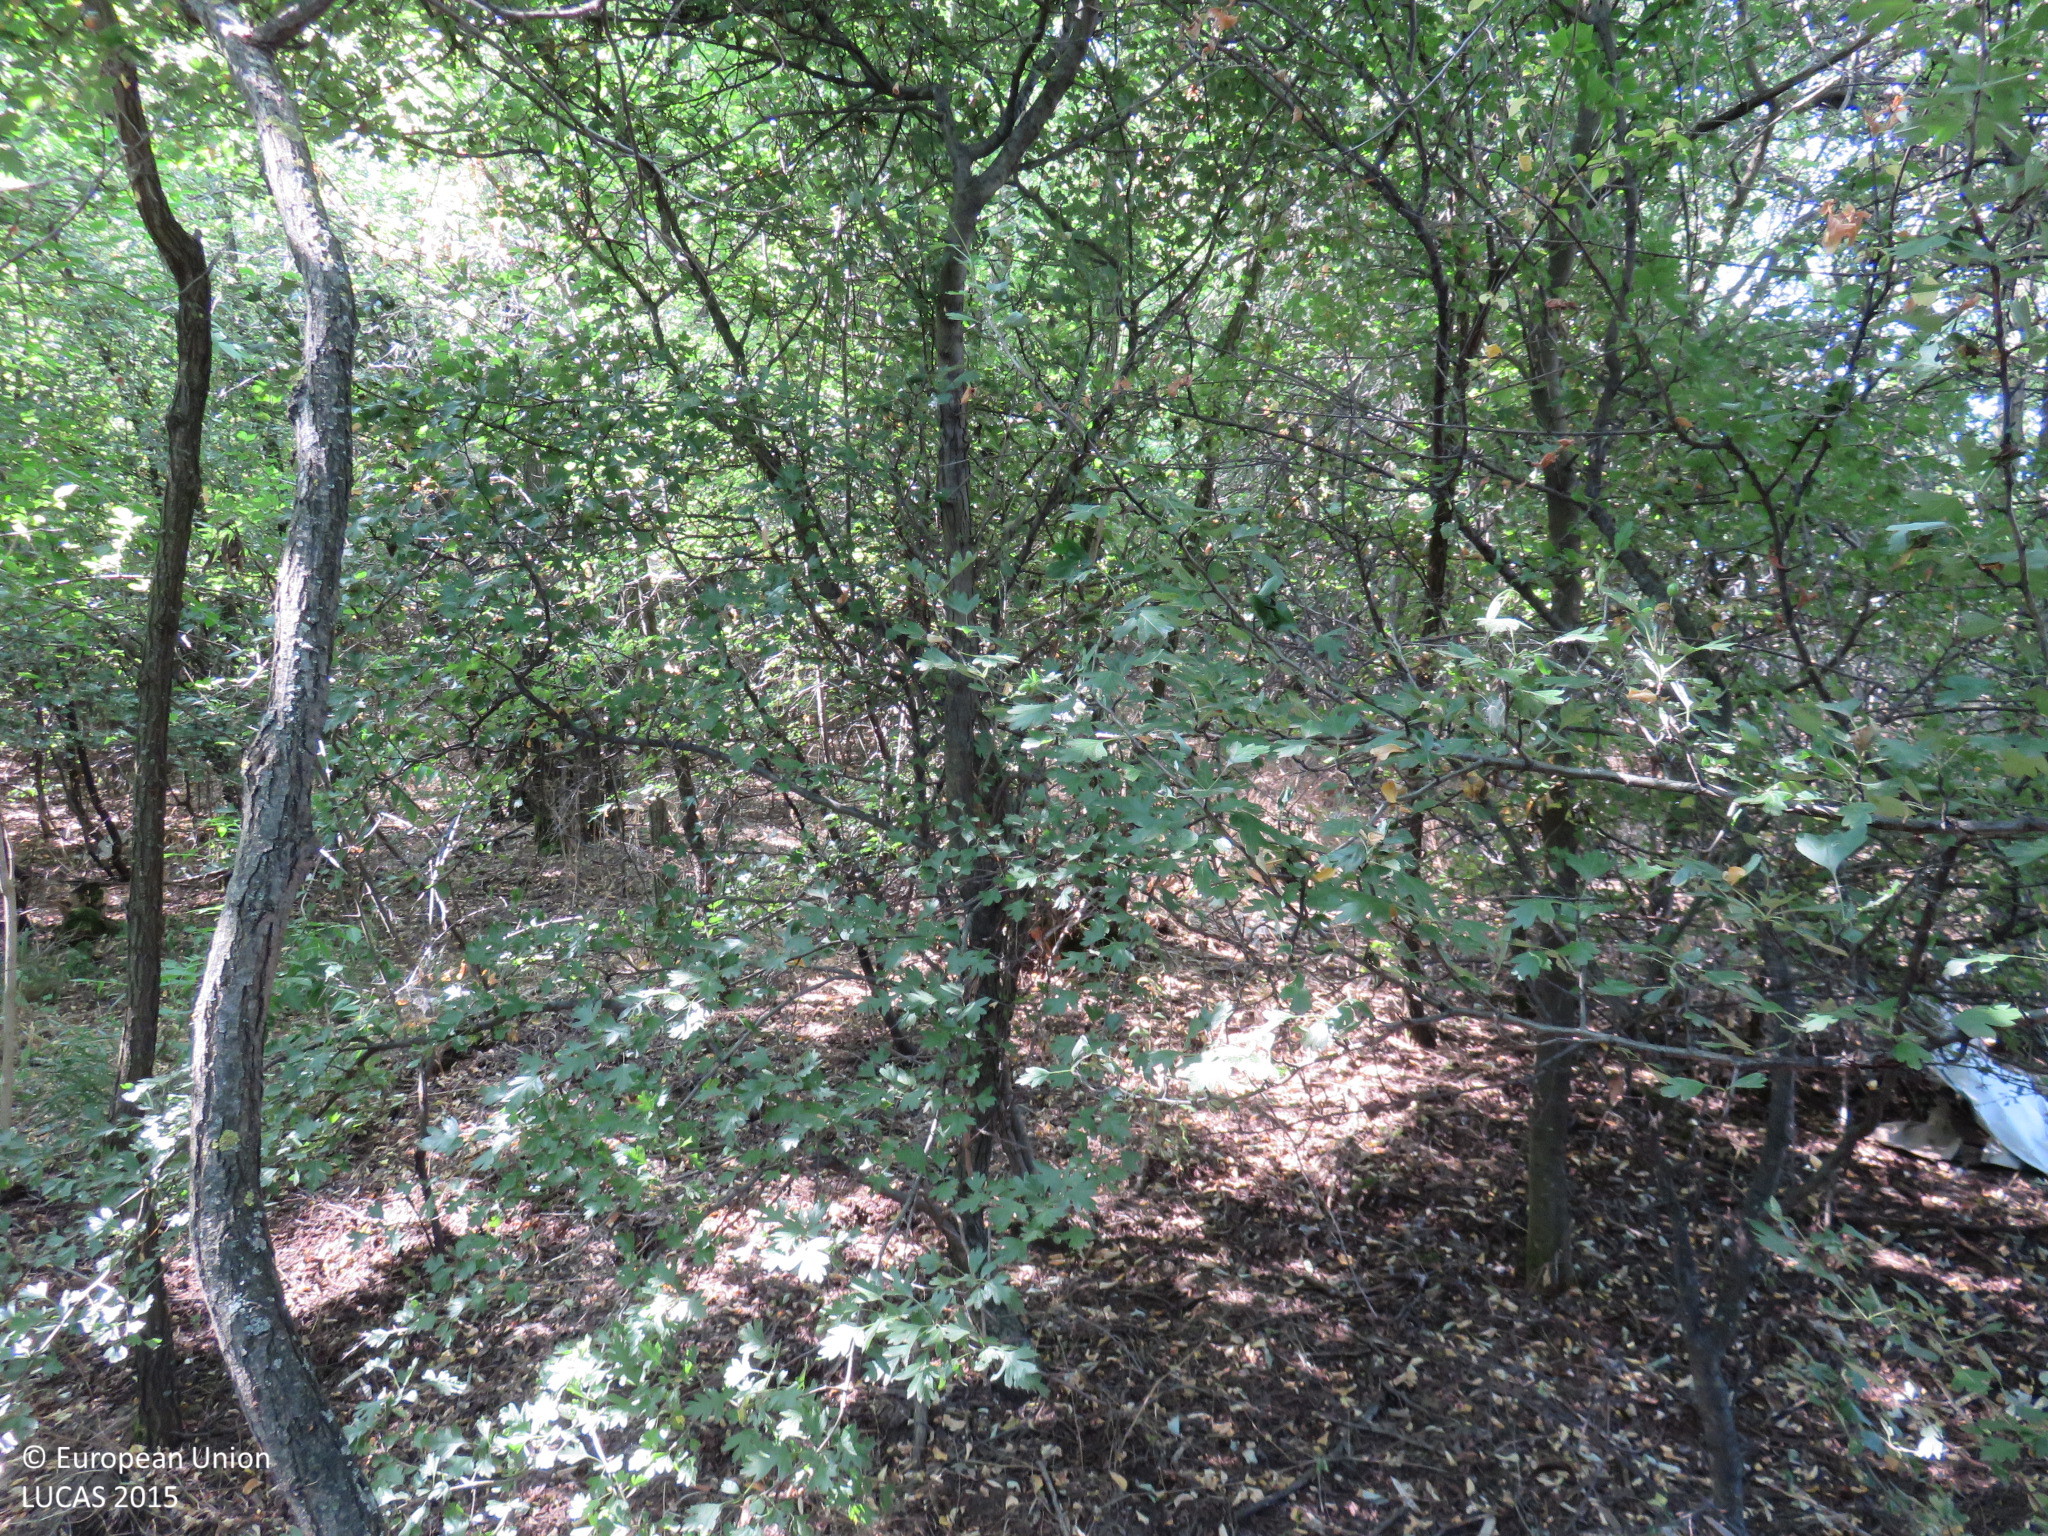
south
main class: Woodland
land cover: Broadleaved woodland
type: mesophytic deciduous forest
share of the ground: > 75 %
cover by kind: broadleaved forest trees 95 %, shrubs 5 %
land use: Forestry
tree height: > 5 m
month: July
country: BG
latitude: 43.5228
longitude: 25.1562
